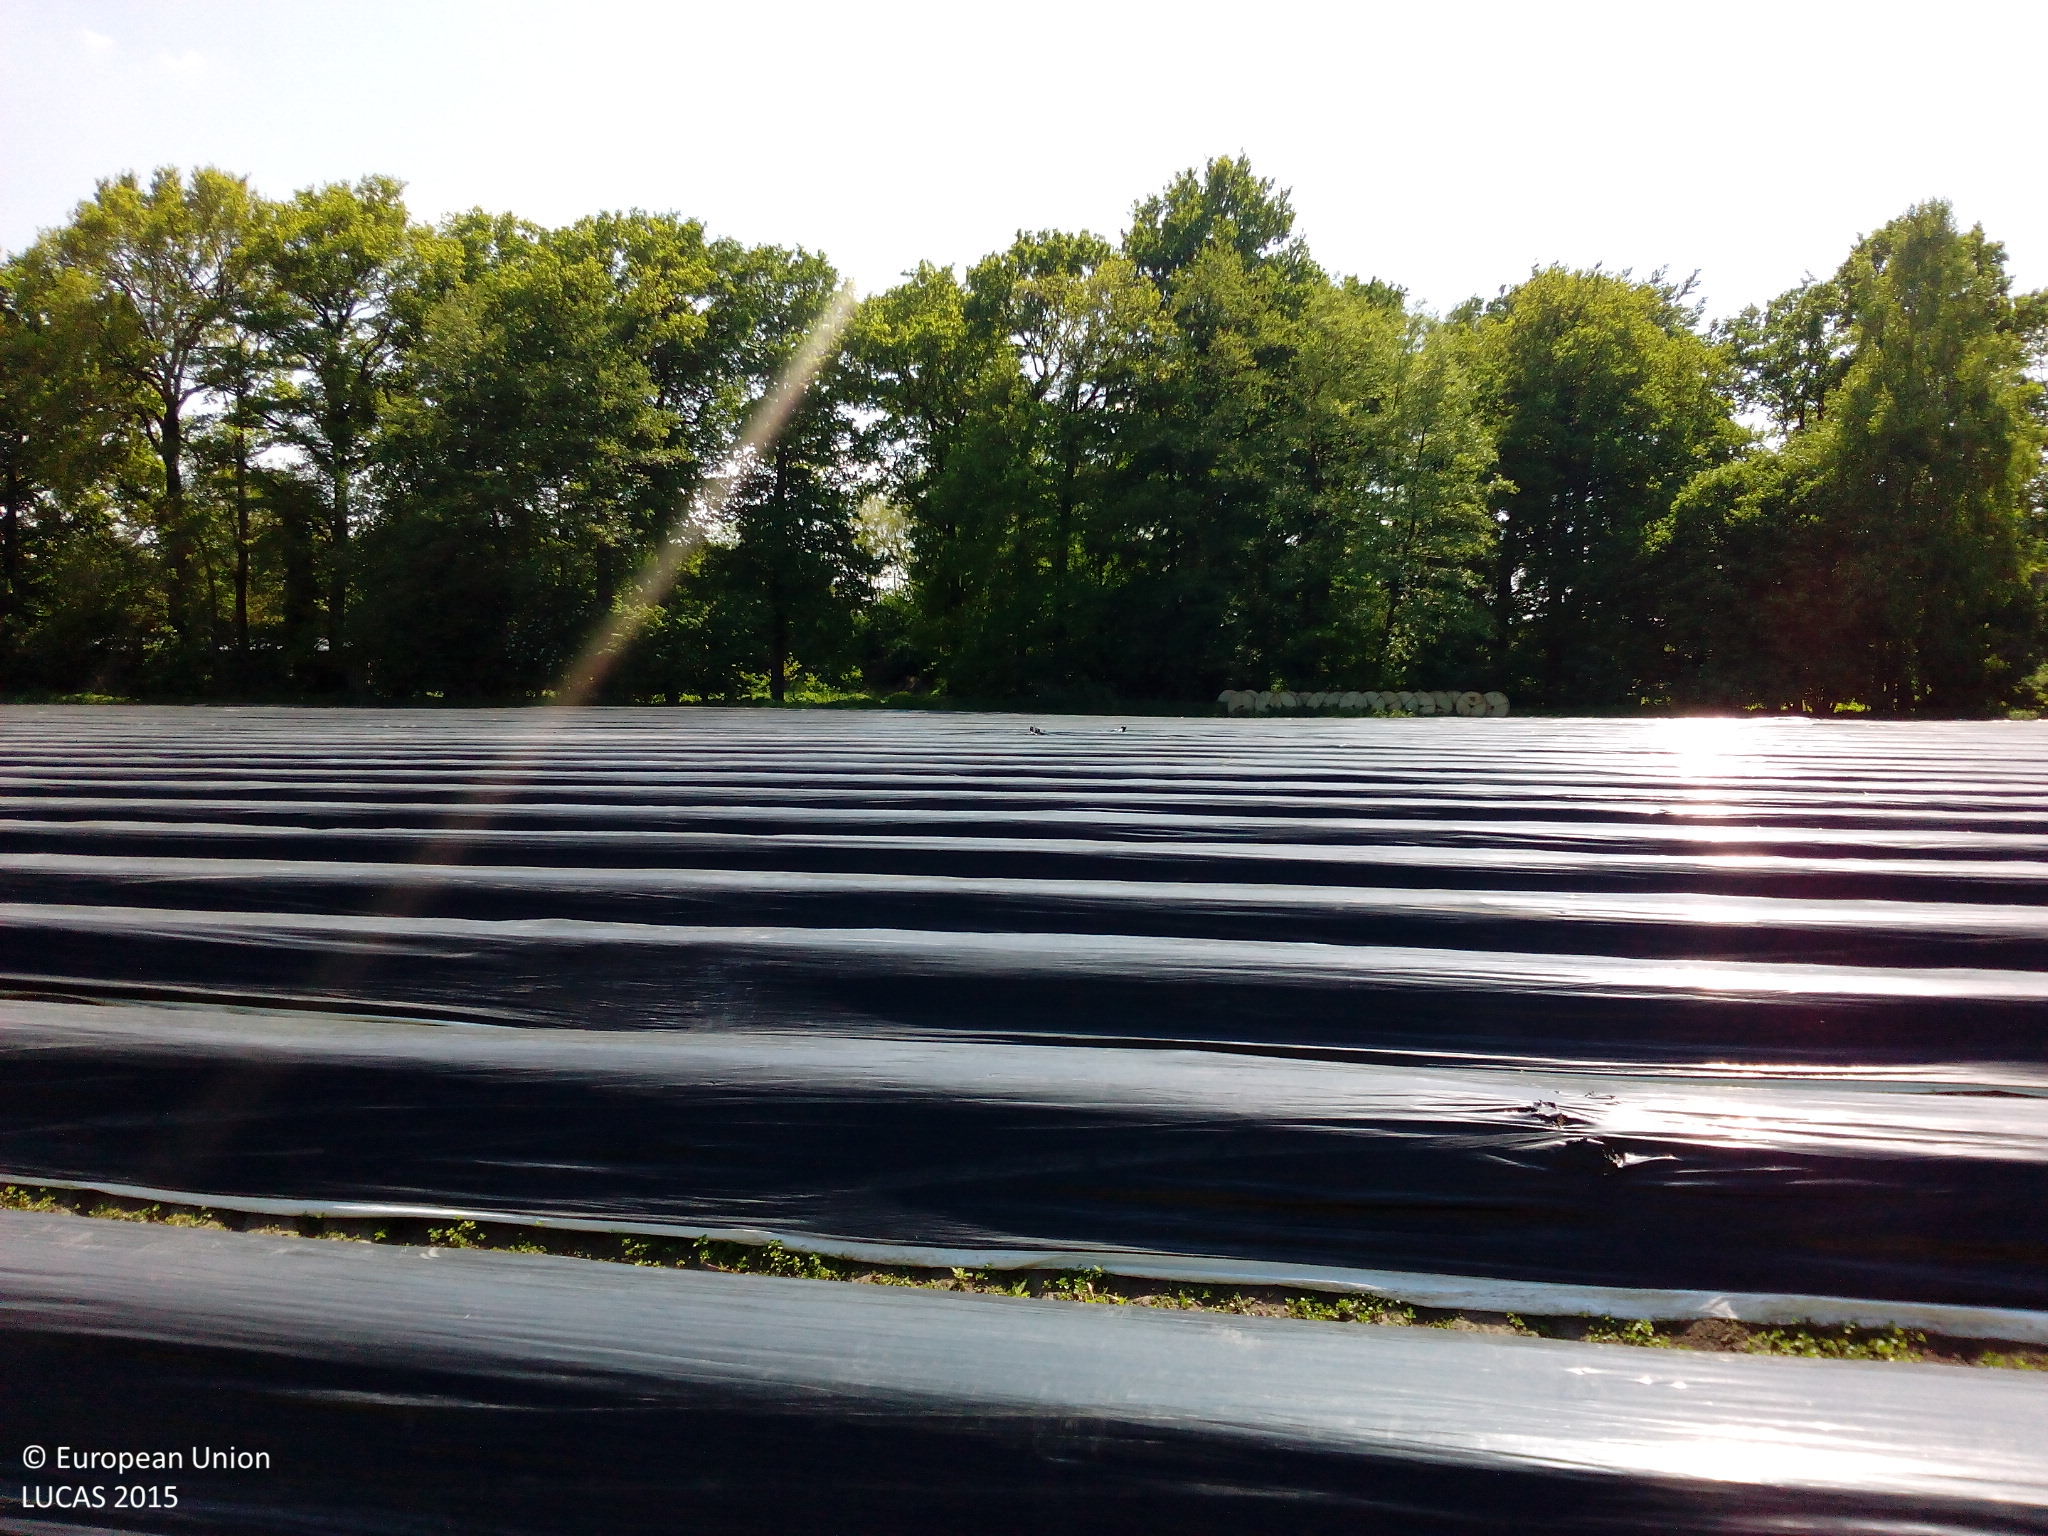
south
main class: Cropland
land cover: Other fresh vegetables
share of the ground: < 10 %
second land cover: Spontaneously vegetated surfaces
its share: 50 - 75 %
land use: Agriculture (excluding fallow land and kitchen gardens)
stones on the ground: < 10 %
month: May
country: DE
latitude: 51.9477
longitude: 8.0363
